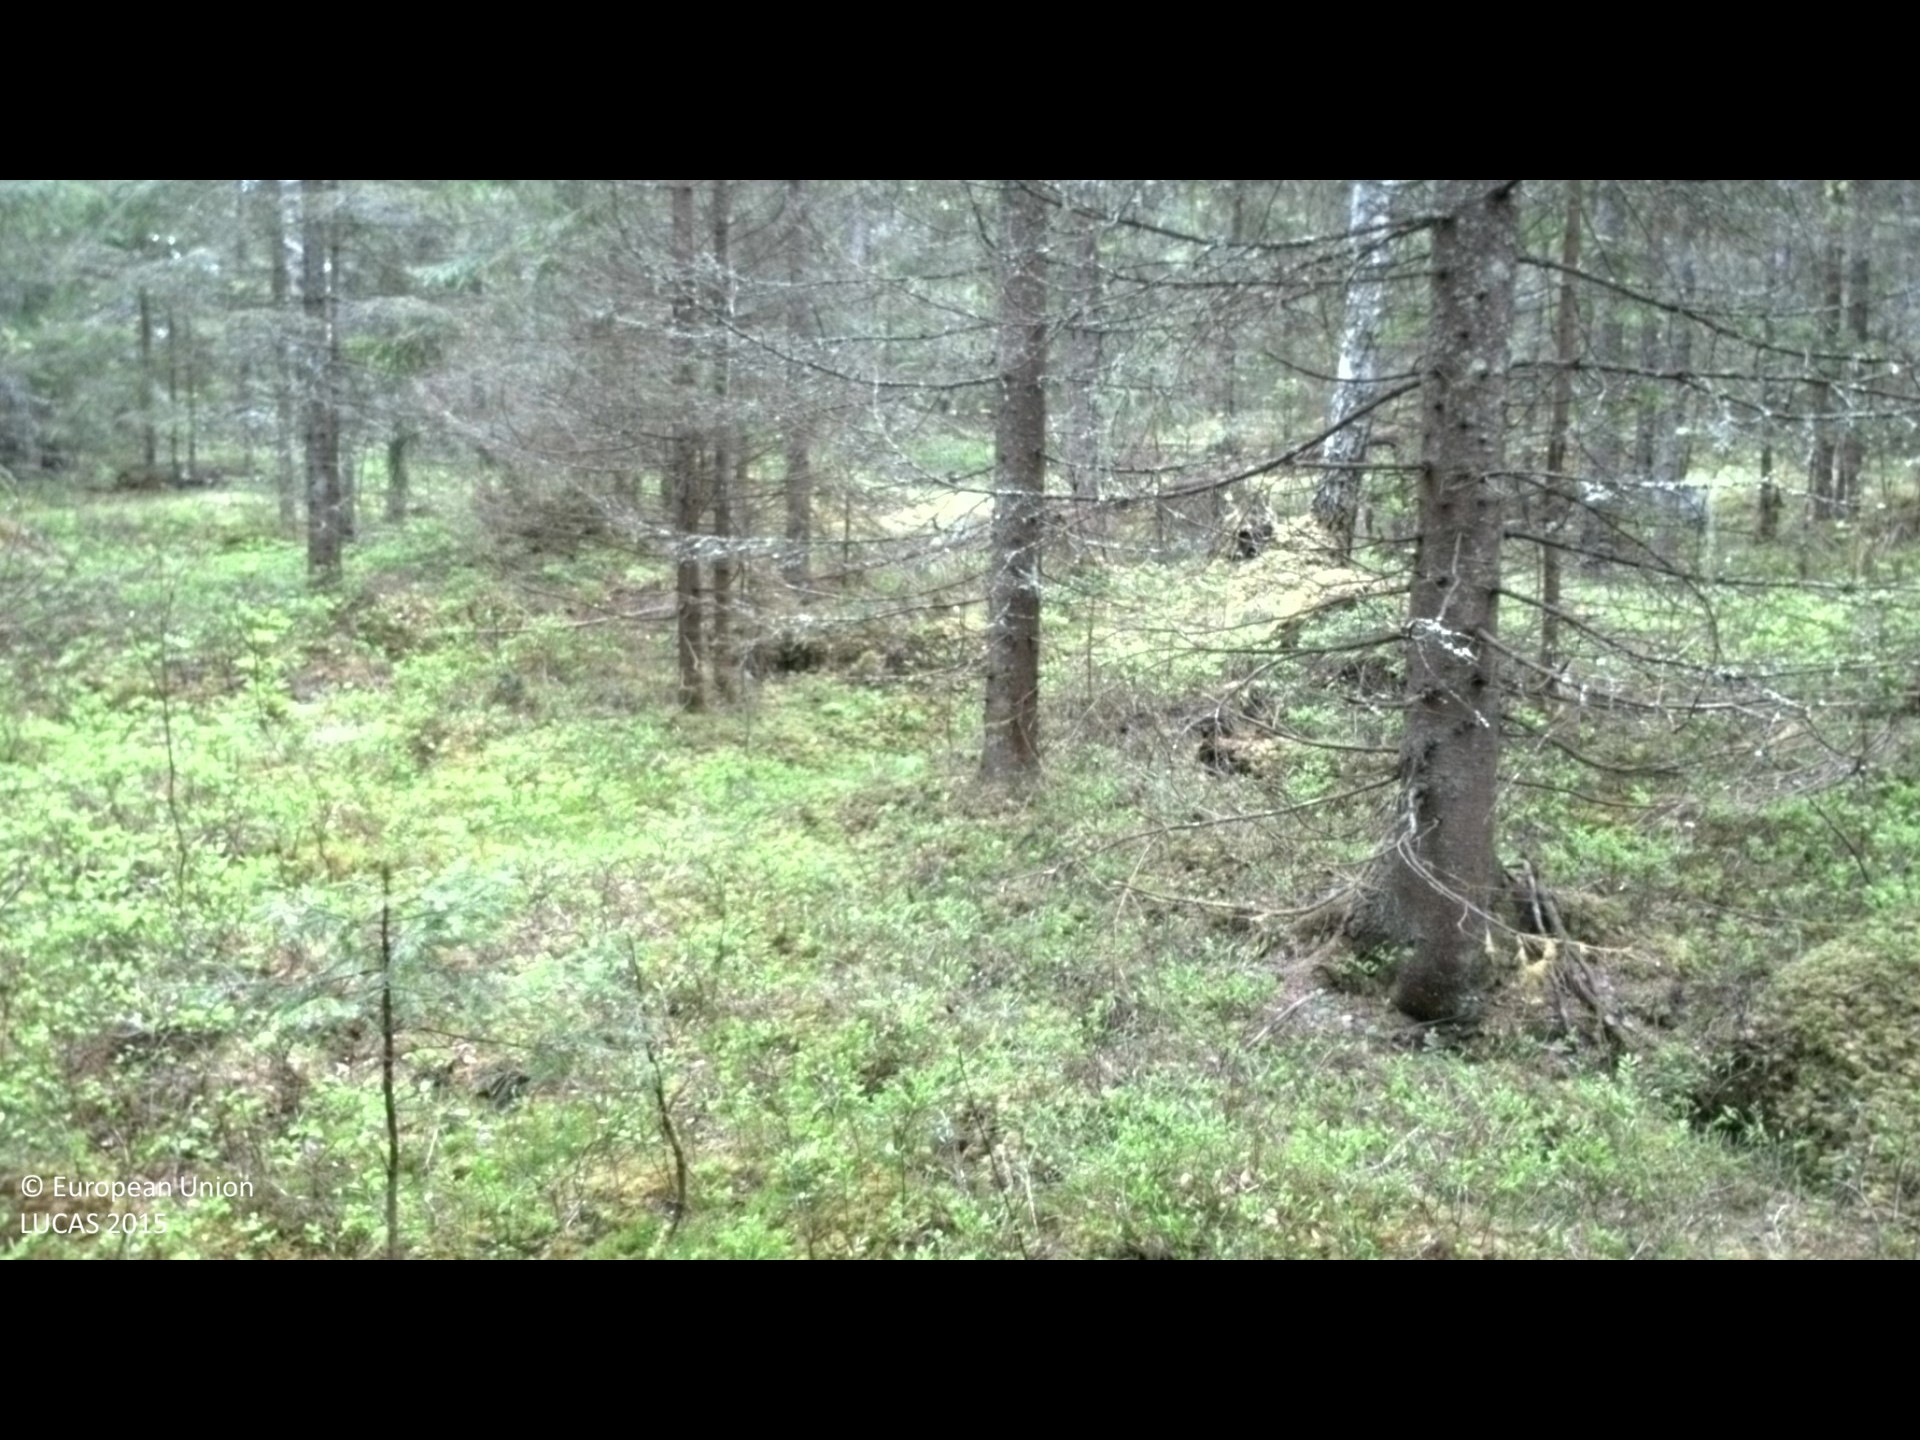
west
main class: Woodland
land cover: Spruce dominated mixed woodland
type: boreal forest
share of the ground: > 75 %
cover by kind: coniferous forest trees 60 %, broadleaved forest trees 20 %, shrubs 20 %
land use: Forestry
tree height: > 5 m
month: May
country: SE
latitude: 62.9777
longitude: 17.6915
